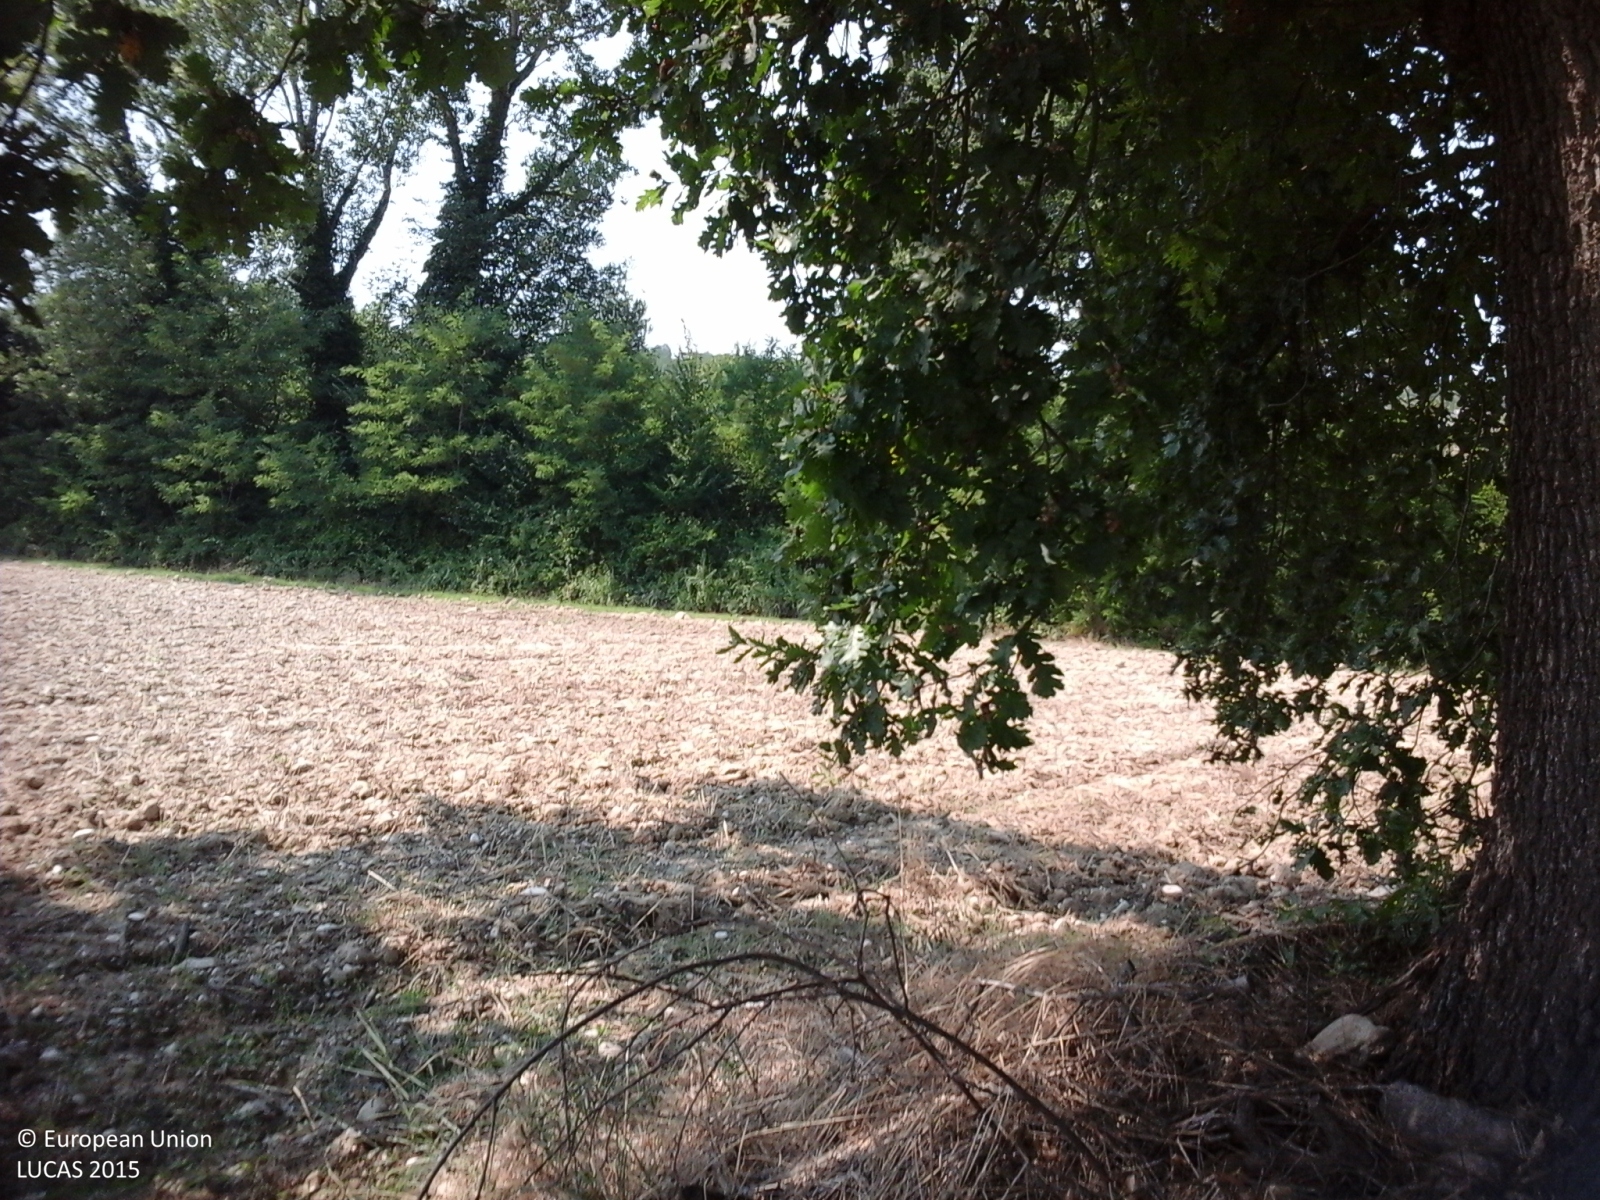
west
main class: Woodland
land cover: Broadleaved woodland
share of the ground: 10 - 25 %
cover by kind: broadleaved forest trees 100 %
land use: Forestry
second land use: Agriculture (excluding fallow land and kitchen gardens)
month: August
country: IT
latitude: 43.0646
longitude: 13.4657
